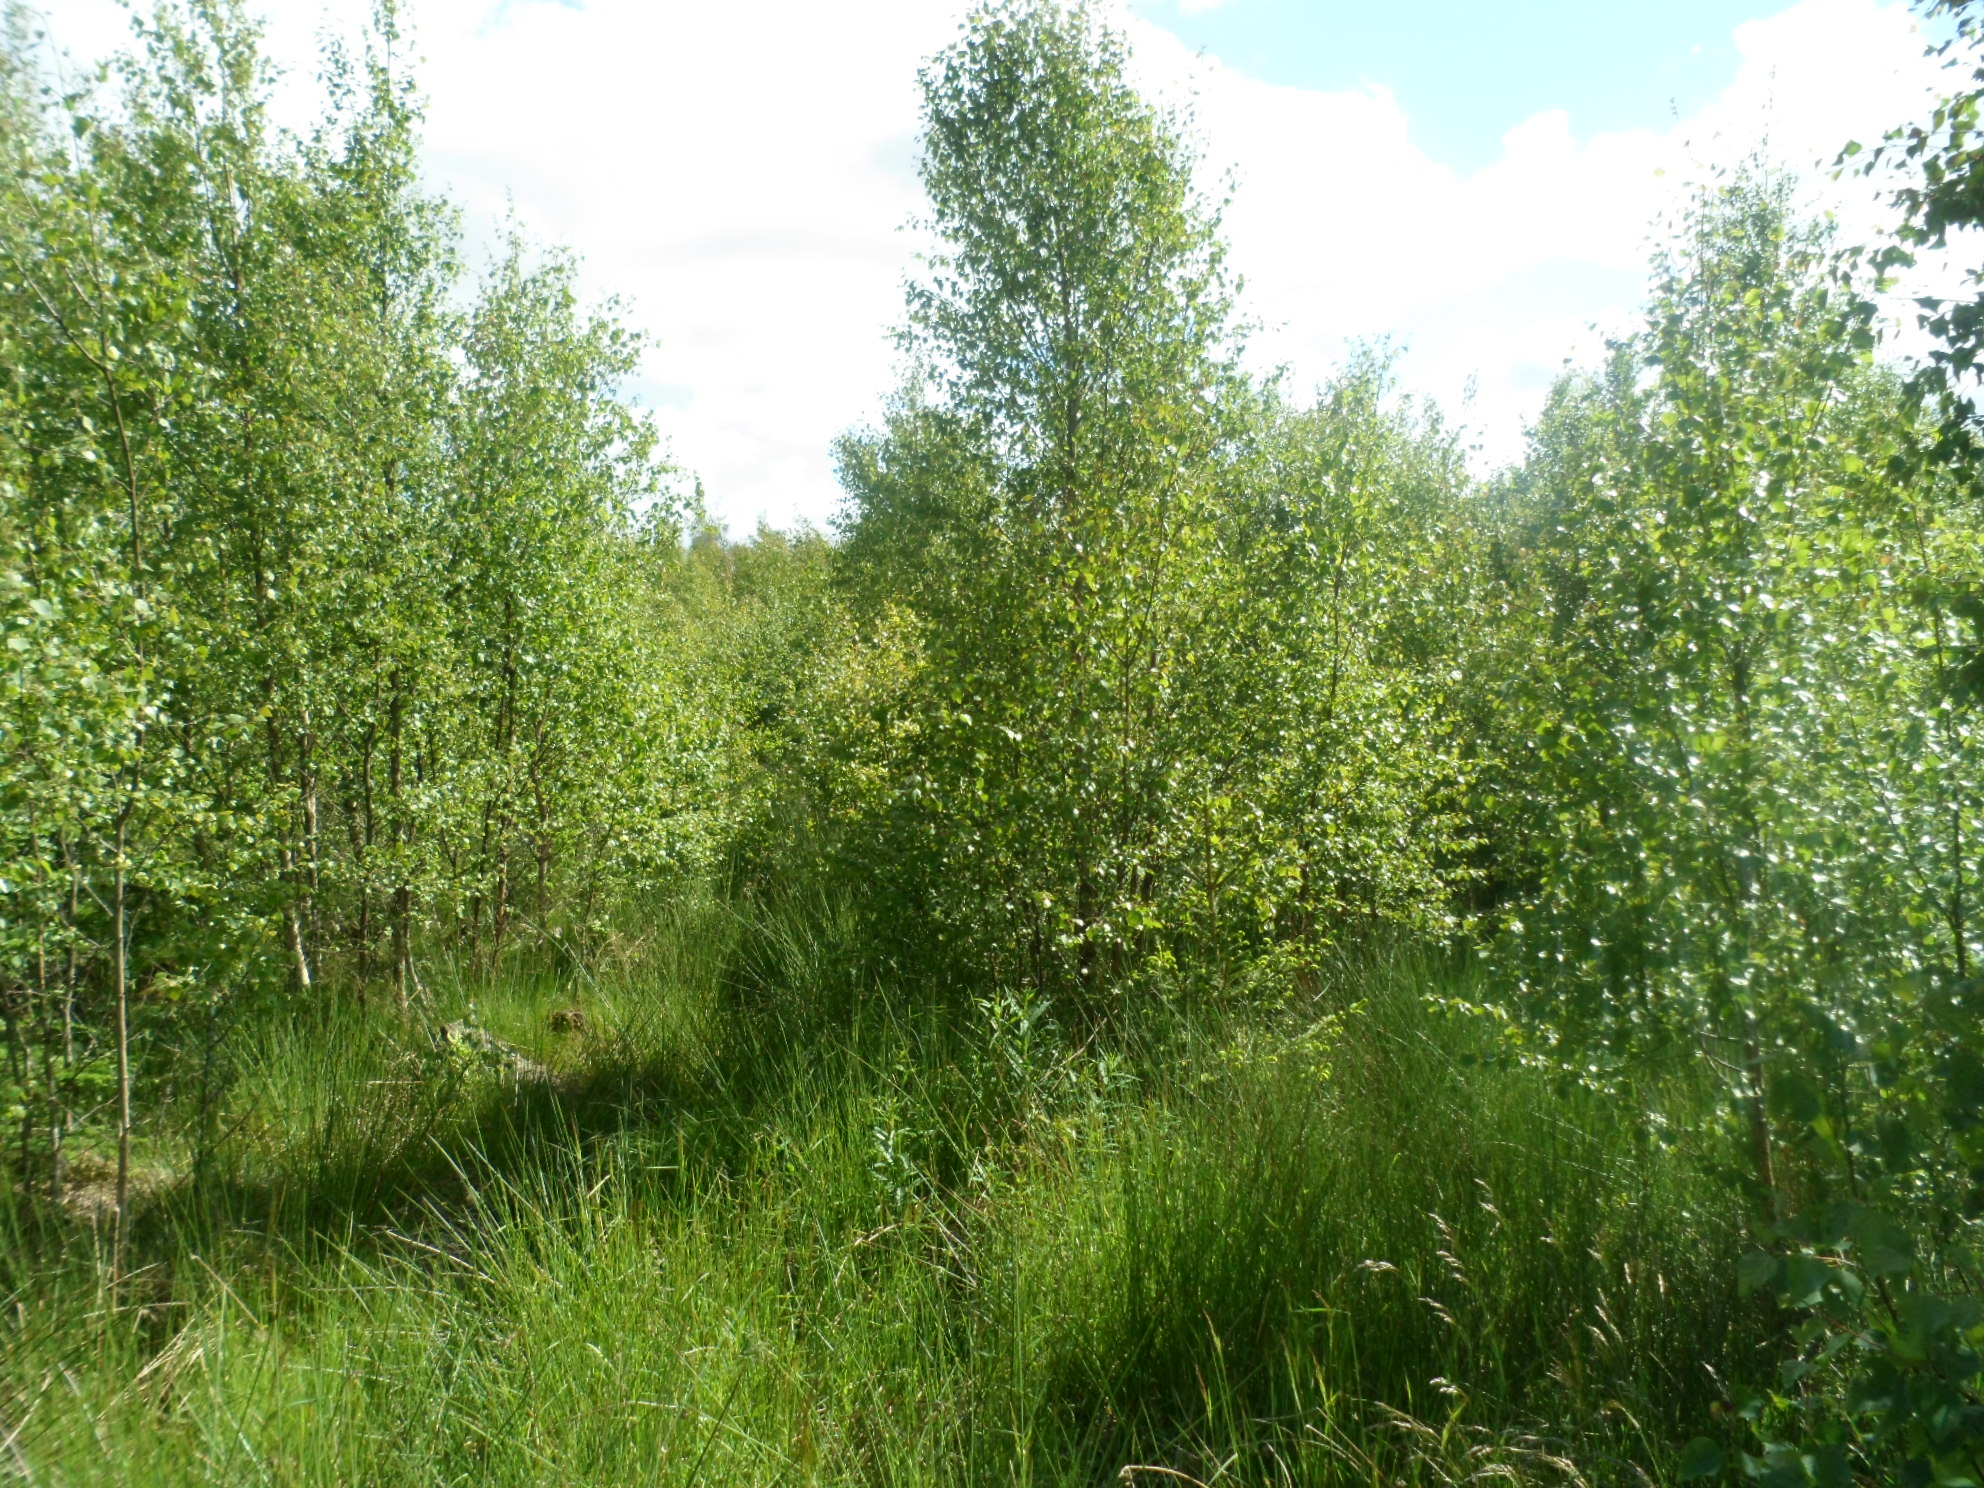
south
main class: Woodland
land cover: Broadleaved woodland
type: hemiboreal forest and nemoral coniferous forest and mixed broadleaved-coniferous forest
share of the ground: 50 - 75 %
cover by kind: broadleaved forest trees 65 %, herbaceous plants 20 %, coniferous forest trees 5 %, shrubs 5 %, lichens and mosses 5 %
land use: Forestry
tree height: < 5 m
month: June
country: SE
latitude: 56.9836
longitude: 14.1926
